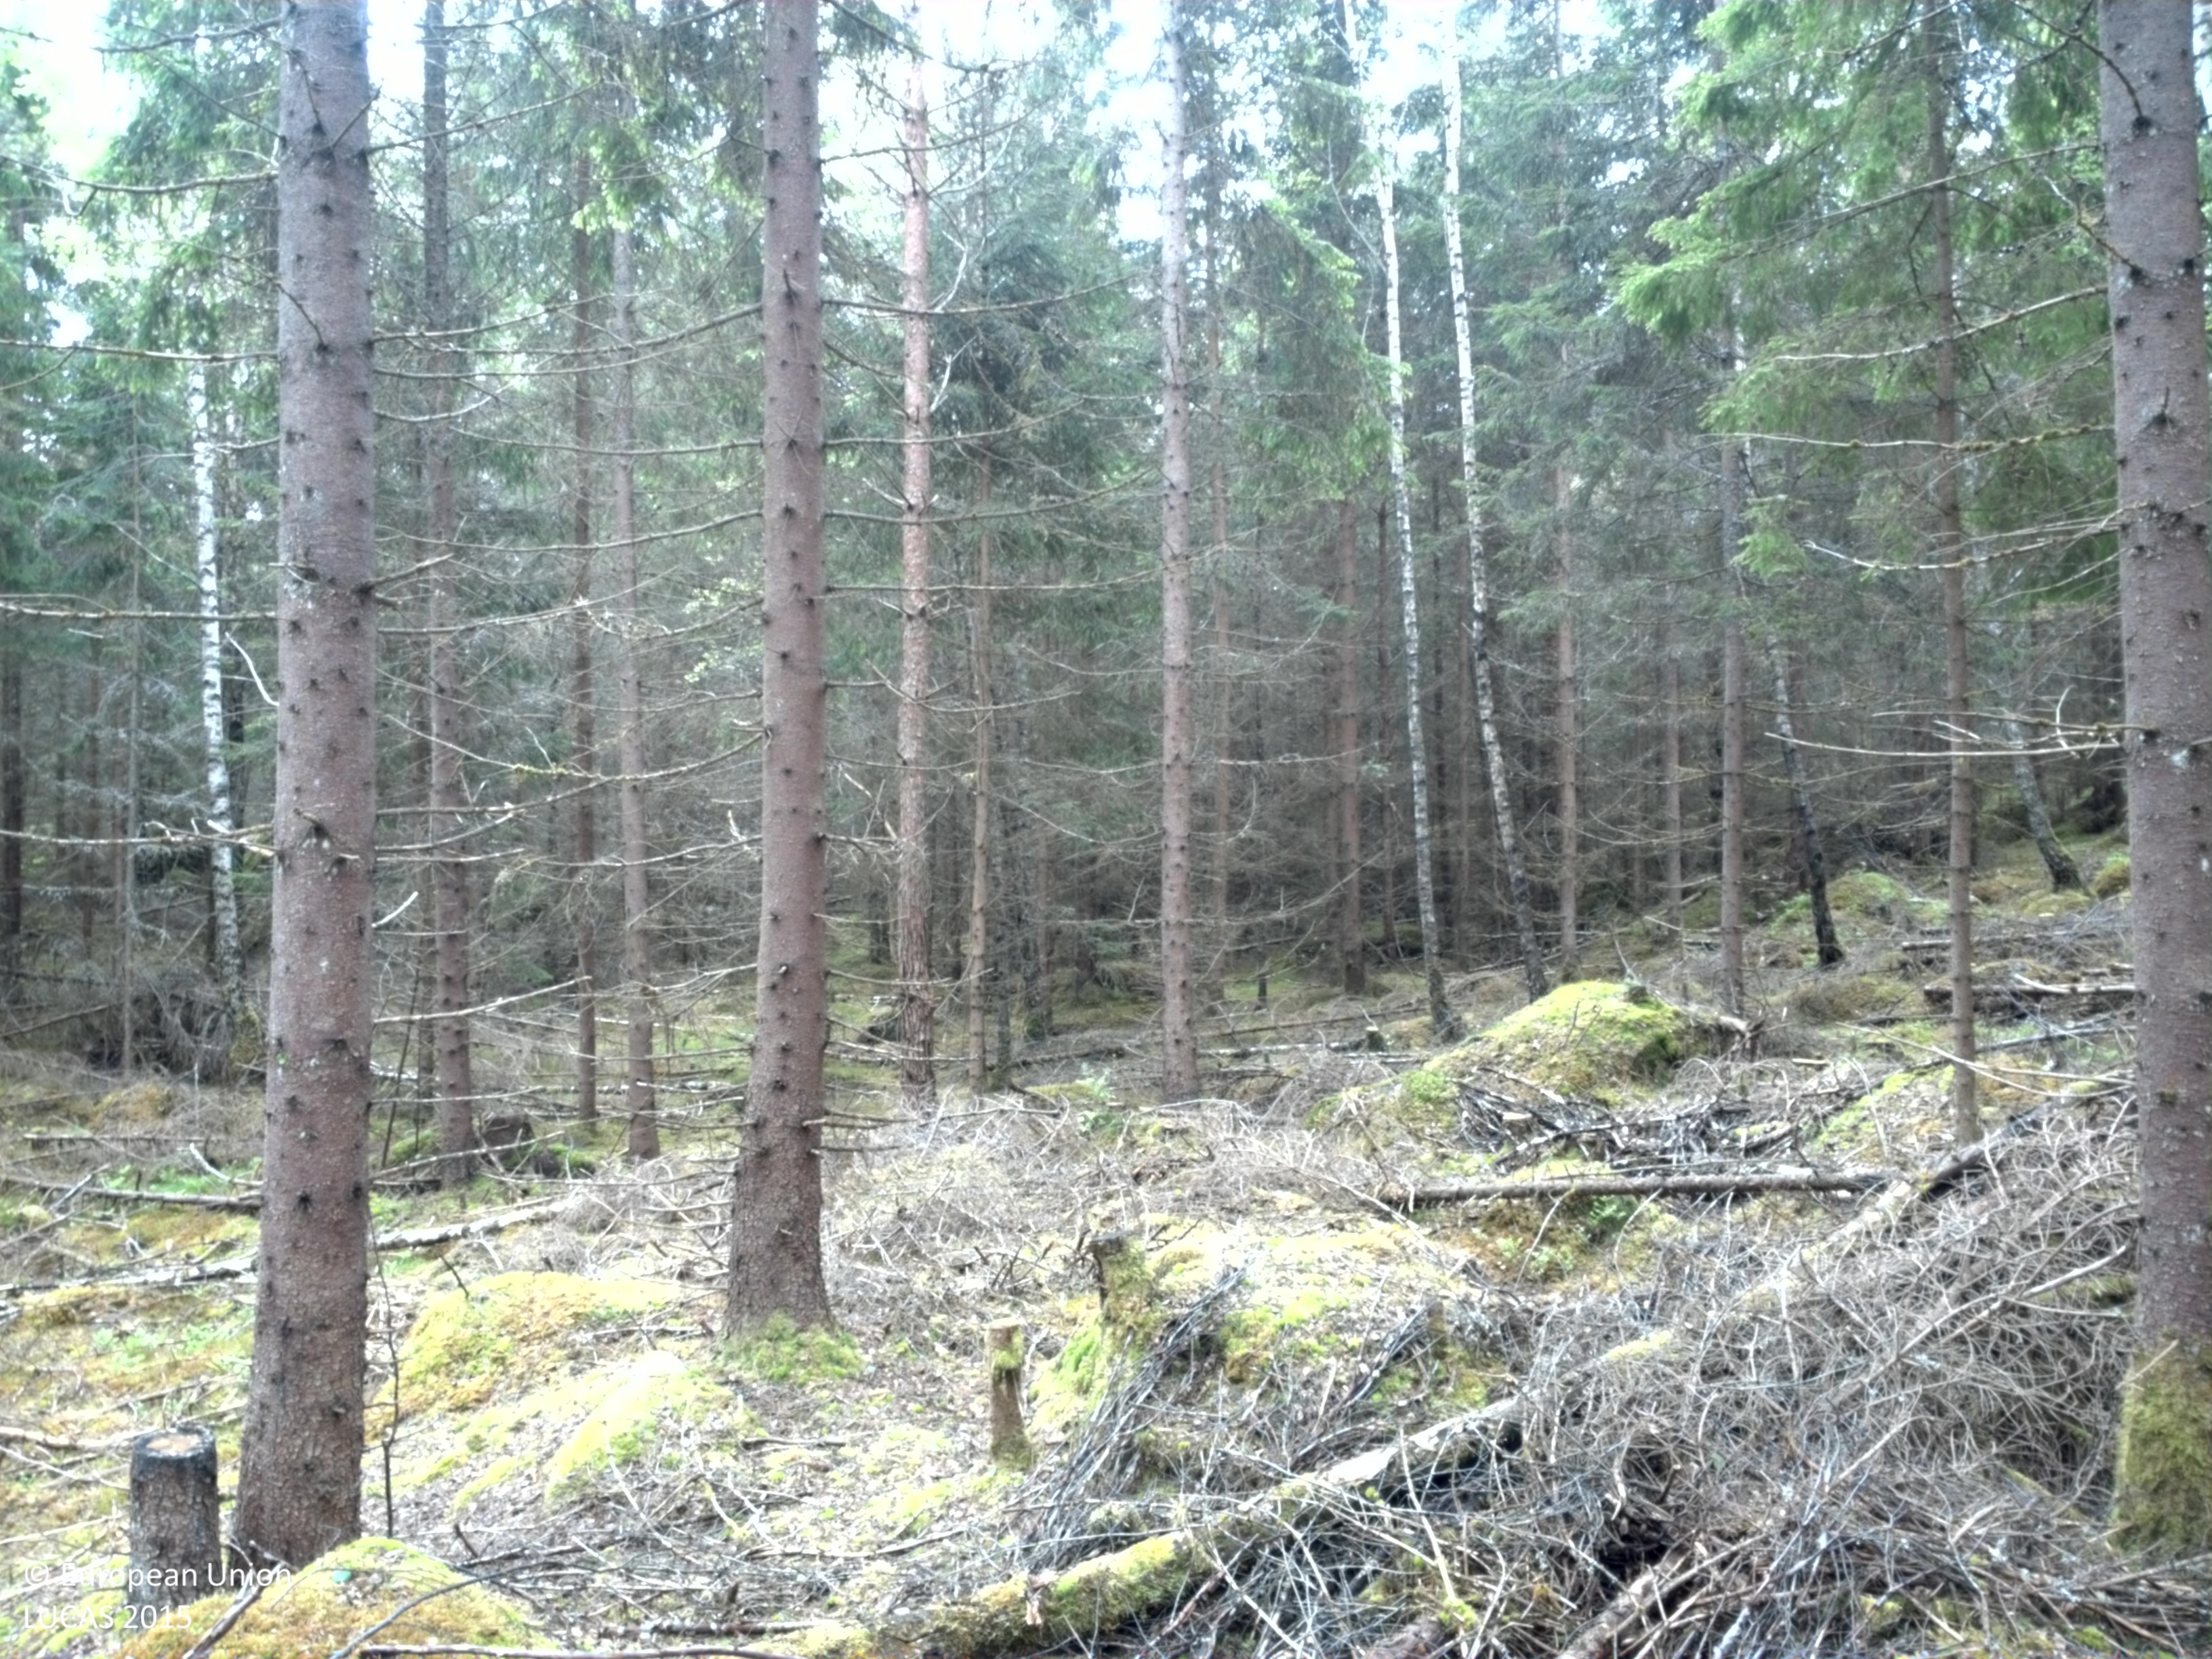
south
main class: Woodland
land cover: Spruce dominated mixed woodland
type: boreal forest
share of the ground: 50 - 75 %
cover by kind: broadleaved forest trees 30 %, lichens and mosses 30 %, coniferous forest trees 25 %, shrubs 10 %, herbaceous plants 5 %
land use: Forestry
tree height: > 5 m
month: June
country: SE
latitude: 56.8482
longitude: 14.4730
